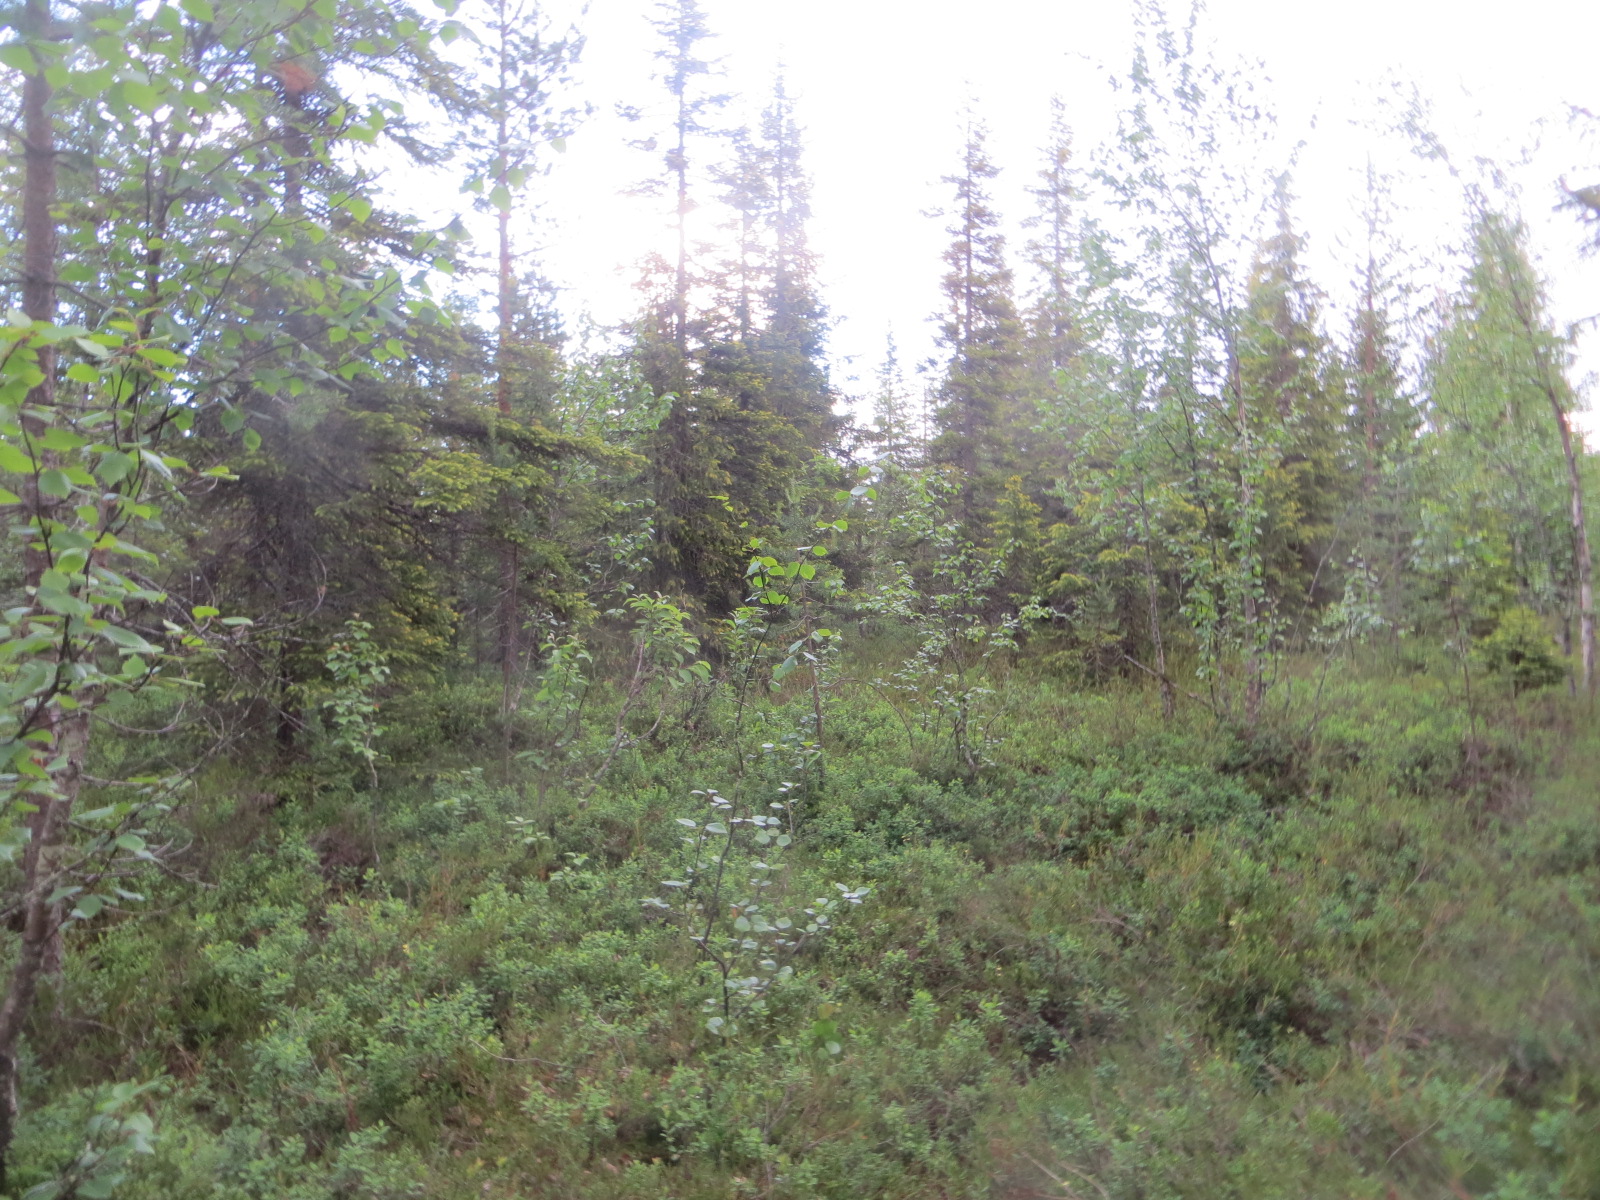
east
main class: Woodland
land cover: Pine dominated mixed woodland
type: boreal forest
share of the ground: 50 - 75 %
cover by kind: shrubs 50 %, coniferous forest trees 25 %, broadleaved forest trees 25 %
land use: Forestry
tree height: > 5 m
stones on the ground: < 10 %
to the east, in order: Pine dominated mixed woodland; Spruce dominated mixed woodland
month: July
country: FI
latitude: 66.2737
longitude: 24.5023
